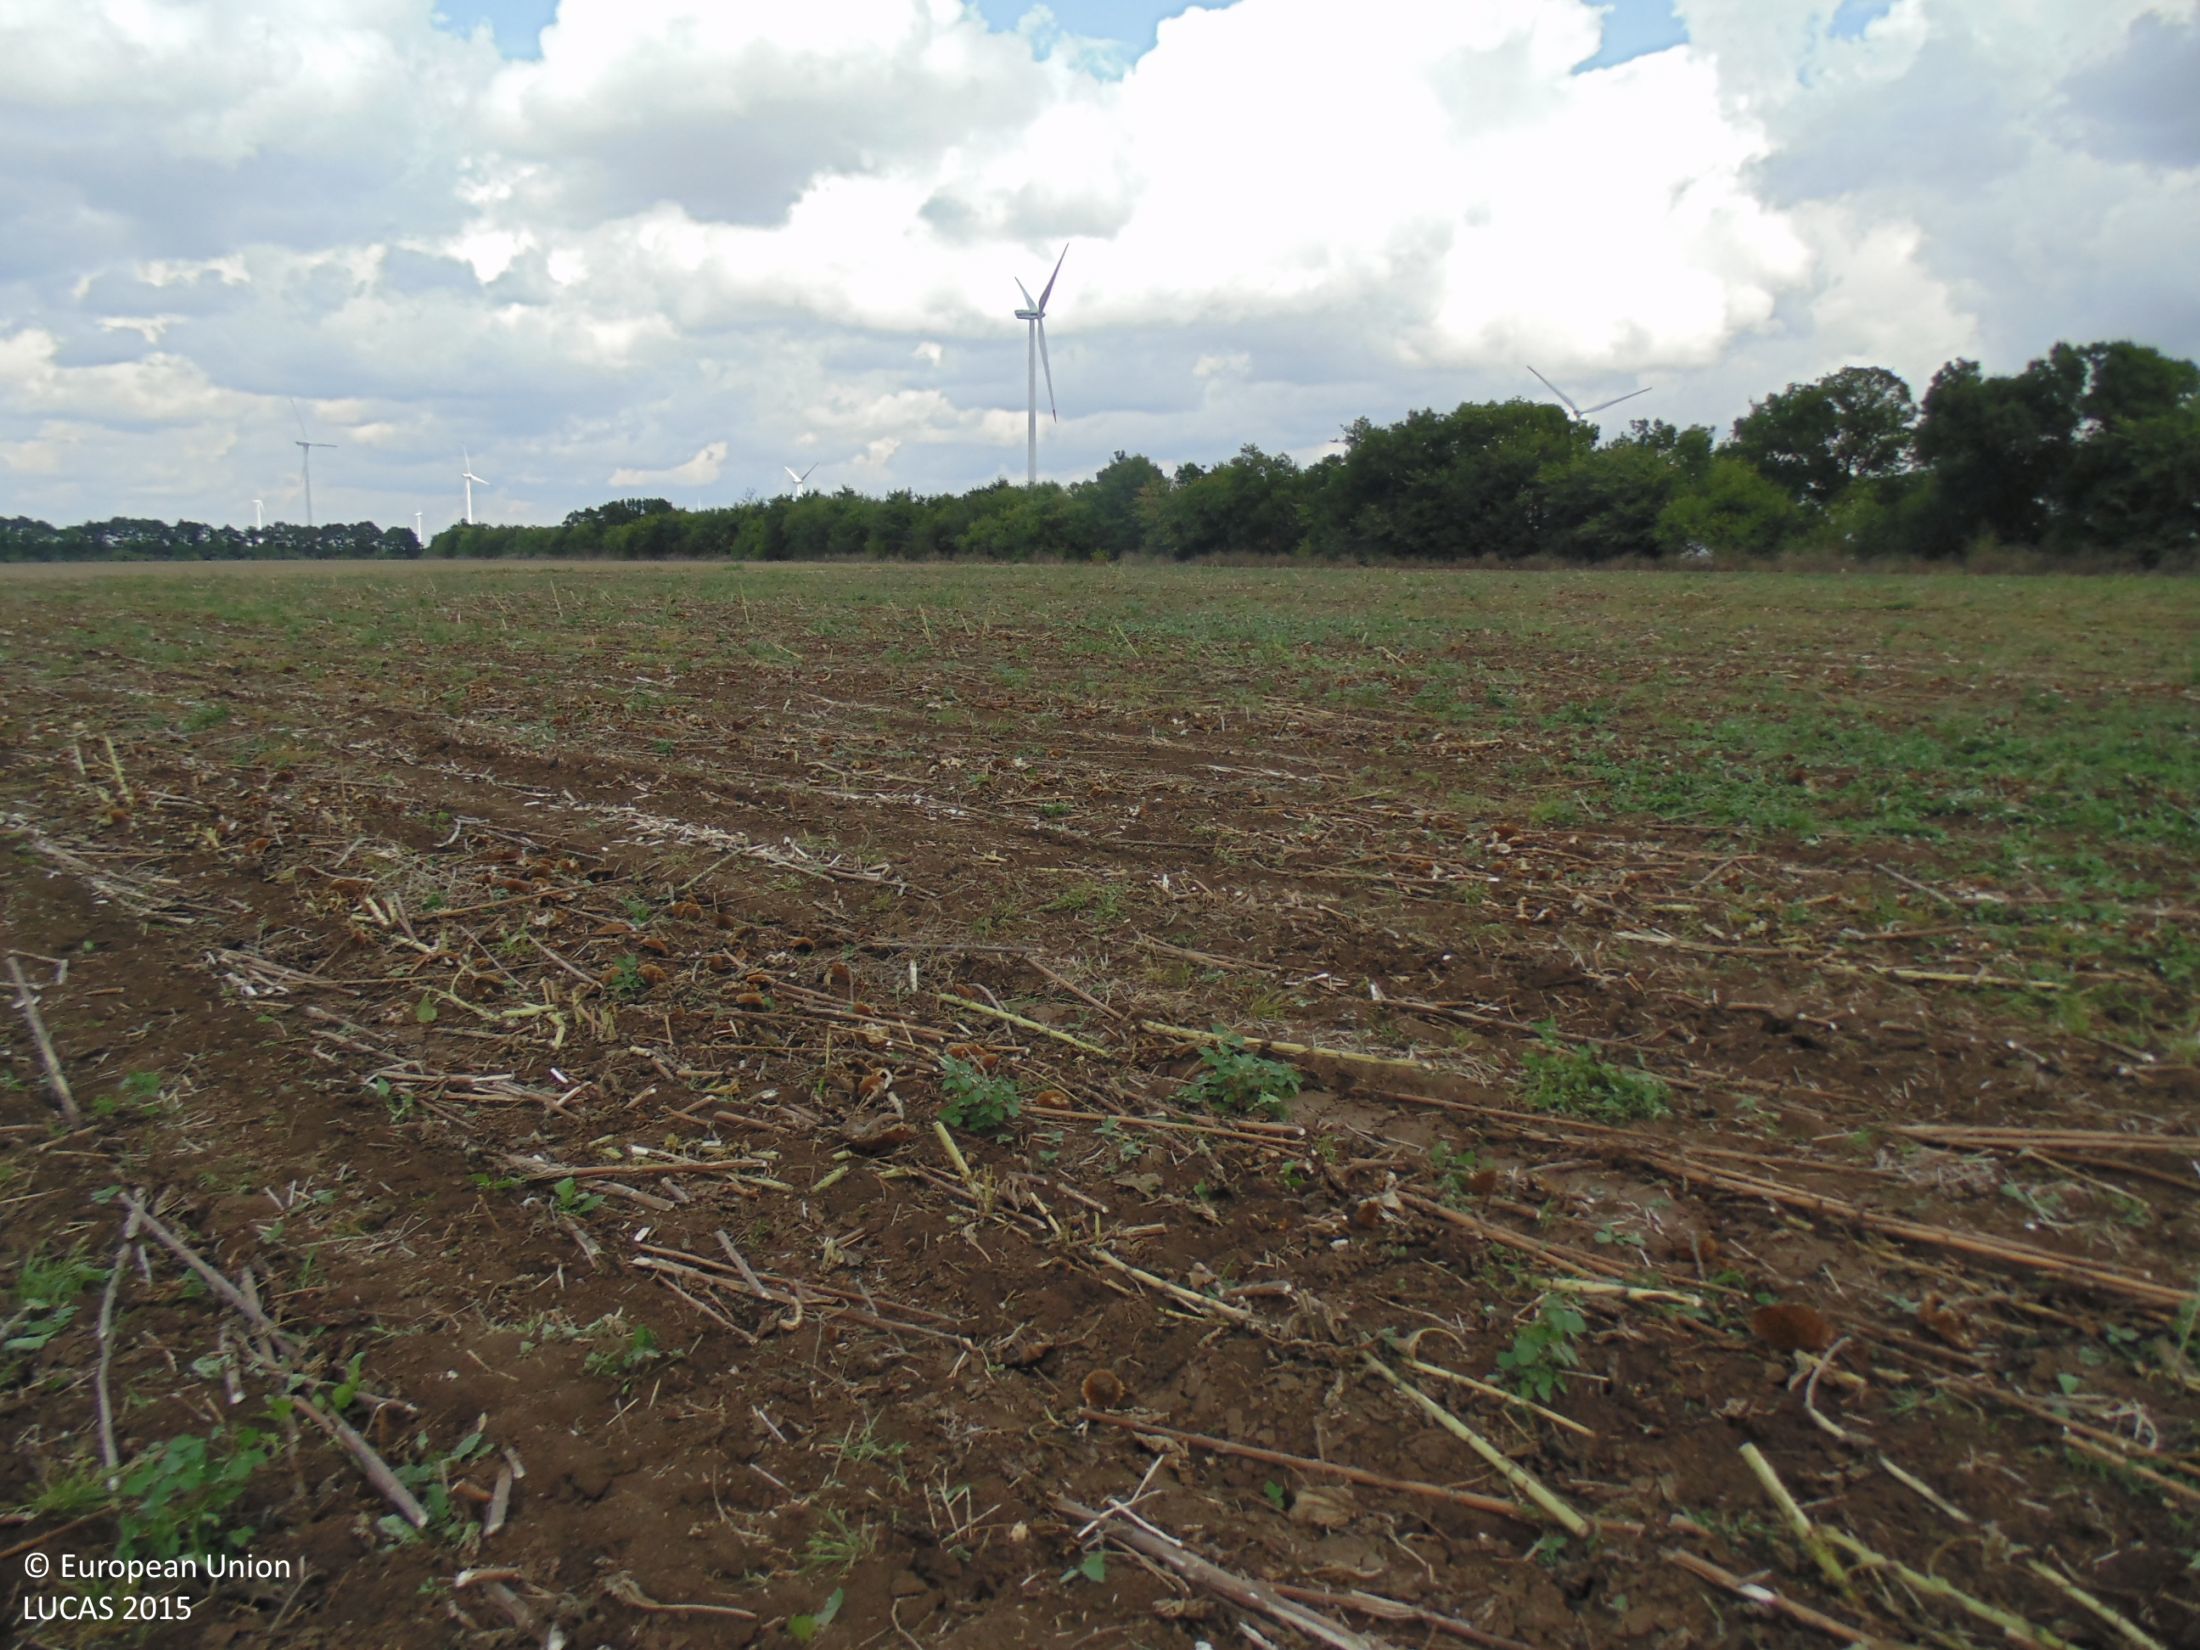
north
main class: Cropland
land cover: Sunflower
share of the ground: < 10 %
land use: Agriculture (excluding fallow land and kitchen gardens)
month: September
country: BG
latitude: 43.4215
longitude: 28.4254
